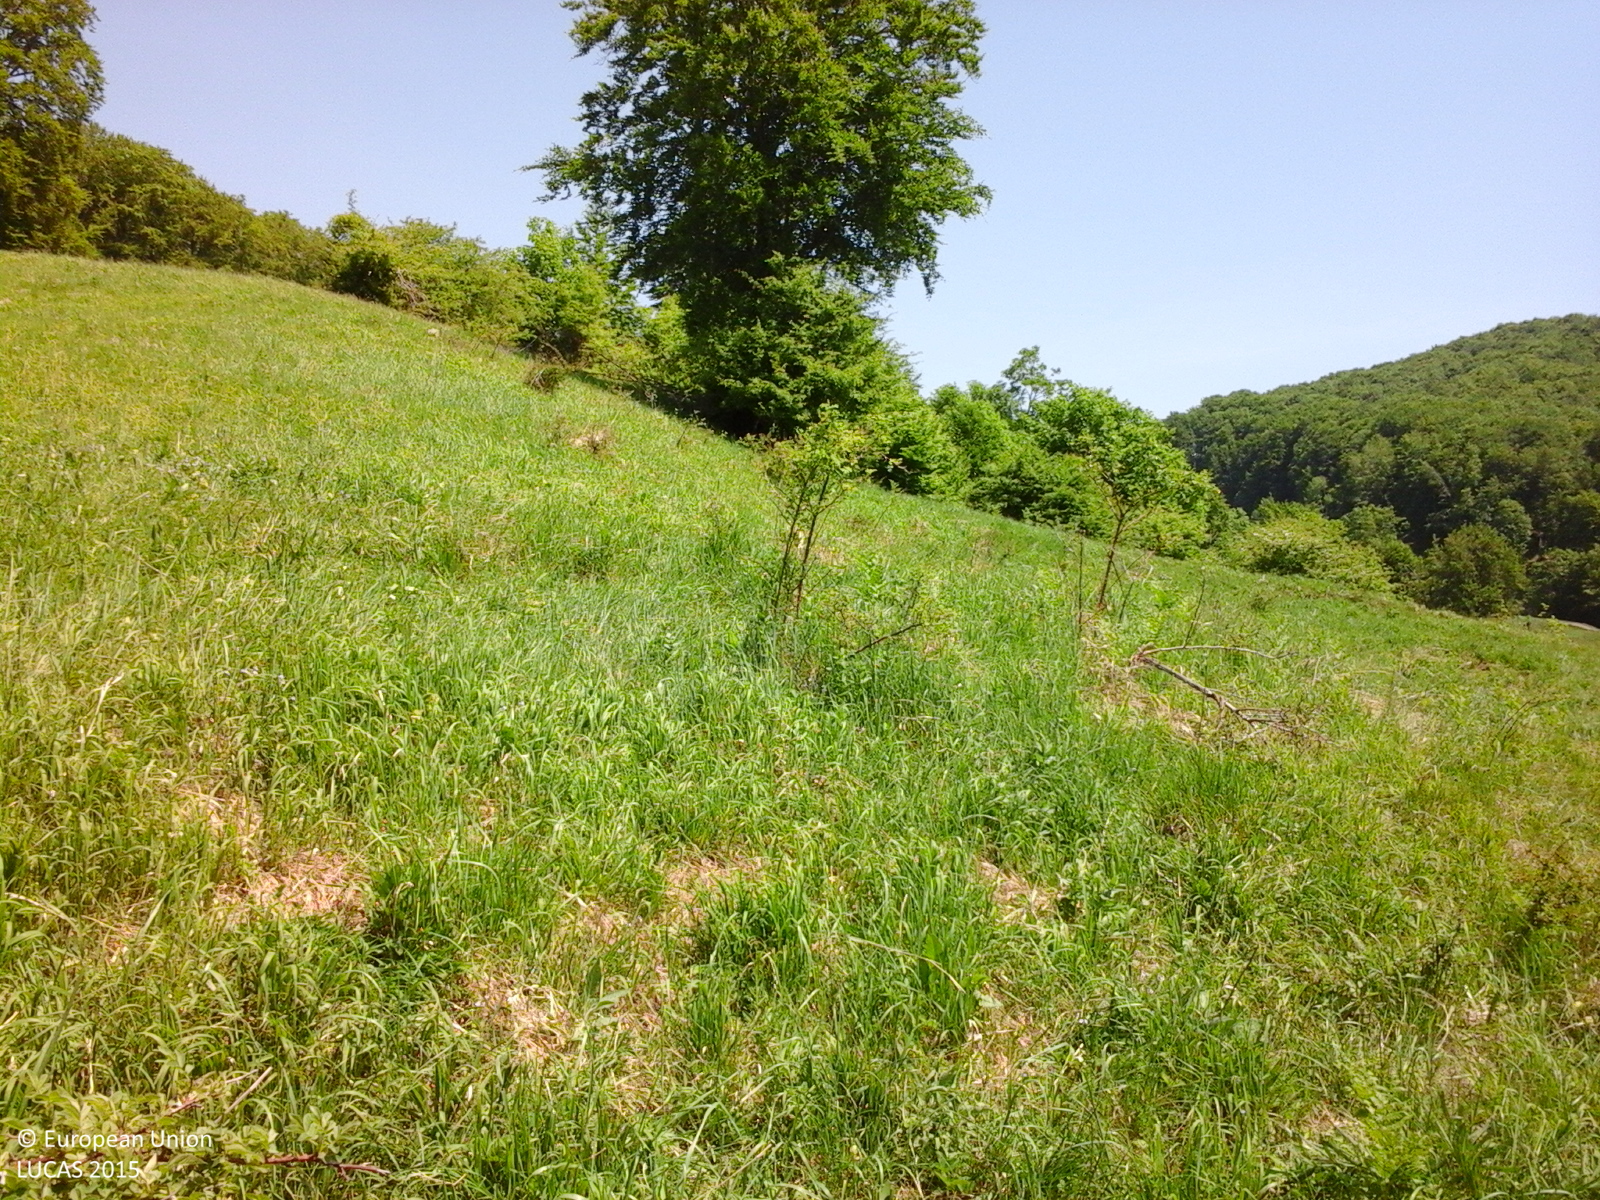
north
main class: Grassland
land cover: Grassland with sparse tree/shrub cover
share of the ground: > 75 %
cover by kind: herbaceous plants 85 %, shrubs 10 %, broadleaved forest trees 5 %
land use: Agriculture (excluding fallow land and kitchen gardens)
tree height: > 5 m
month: May
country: RO
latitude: 45.4306
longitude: 26.2361
